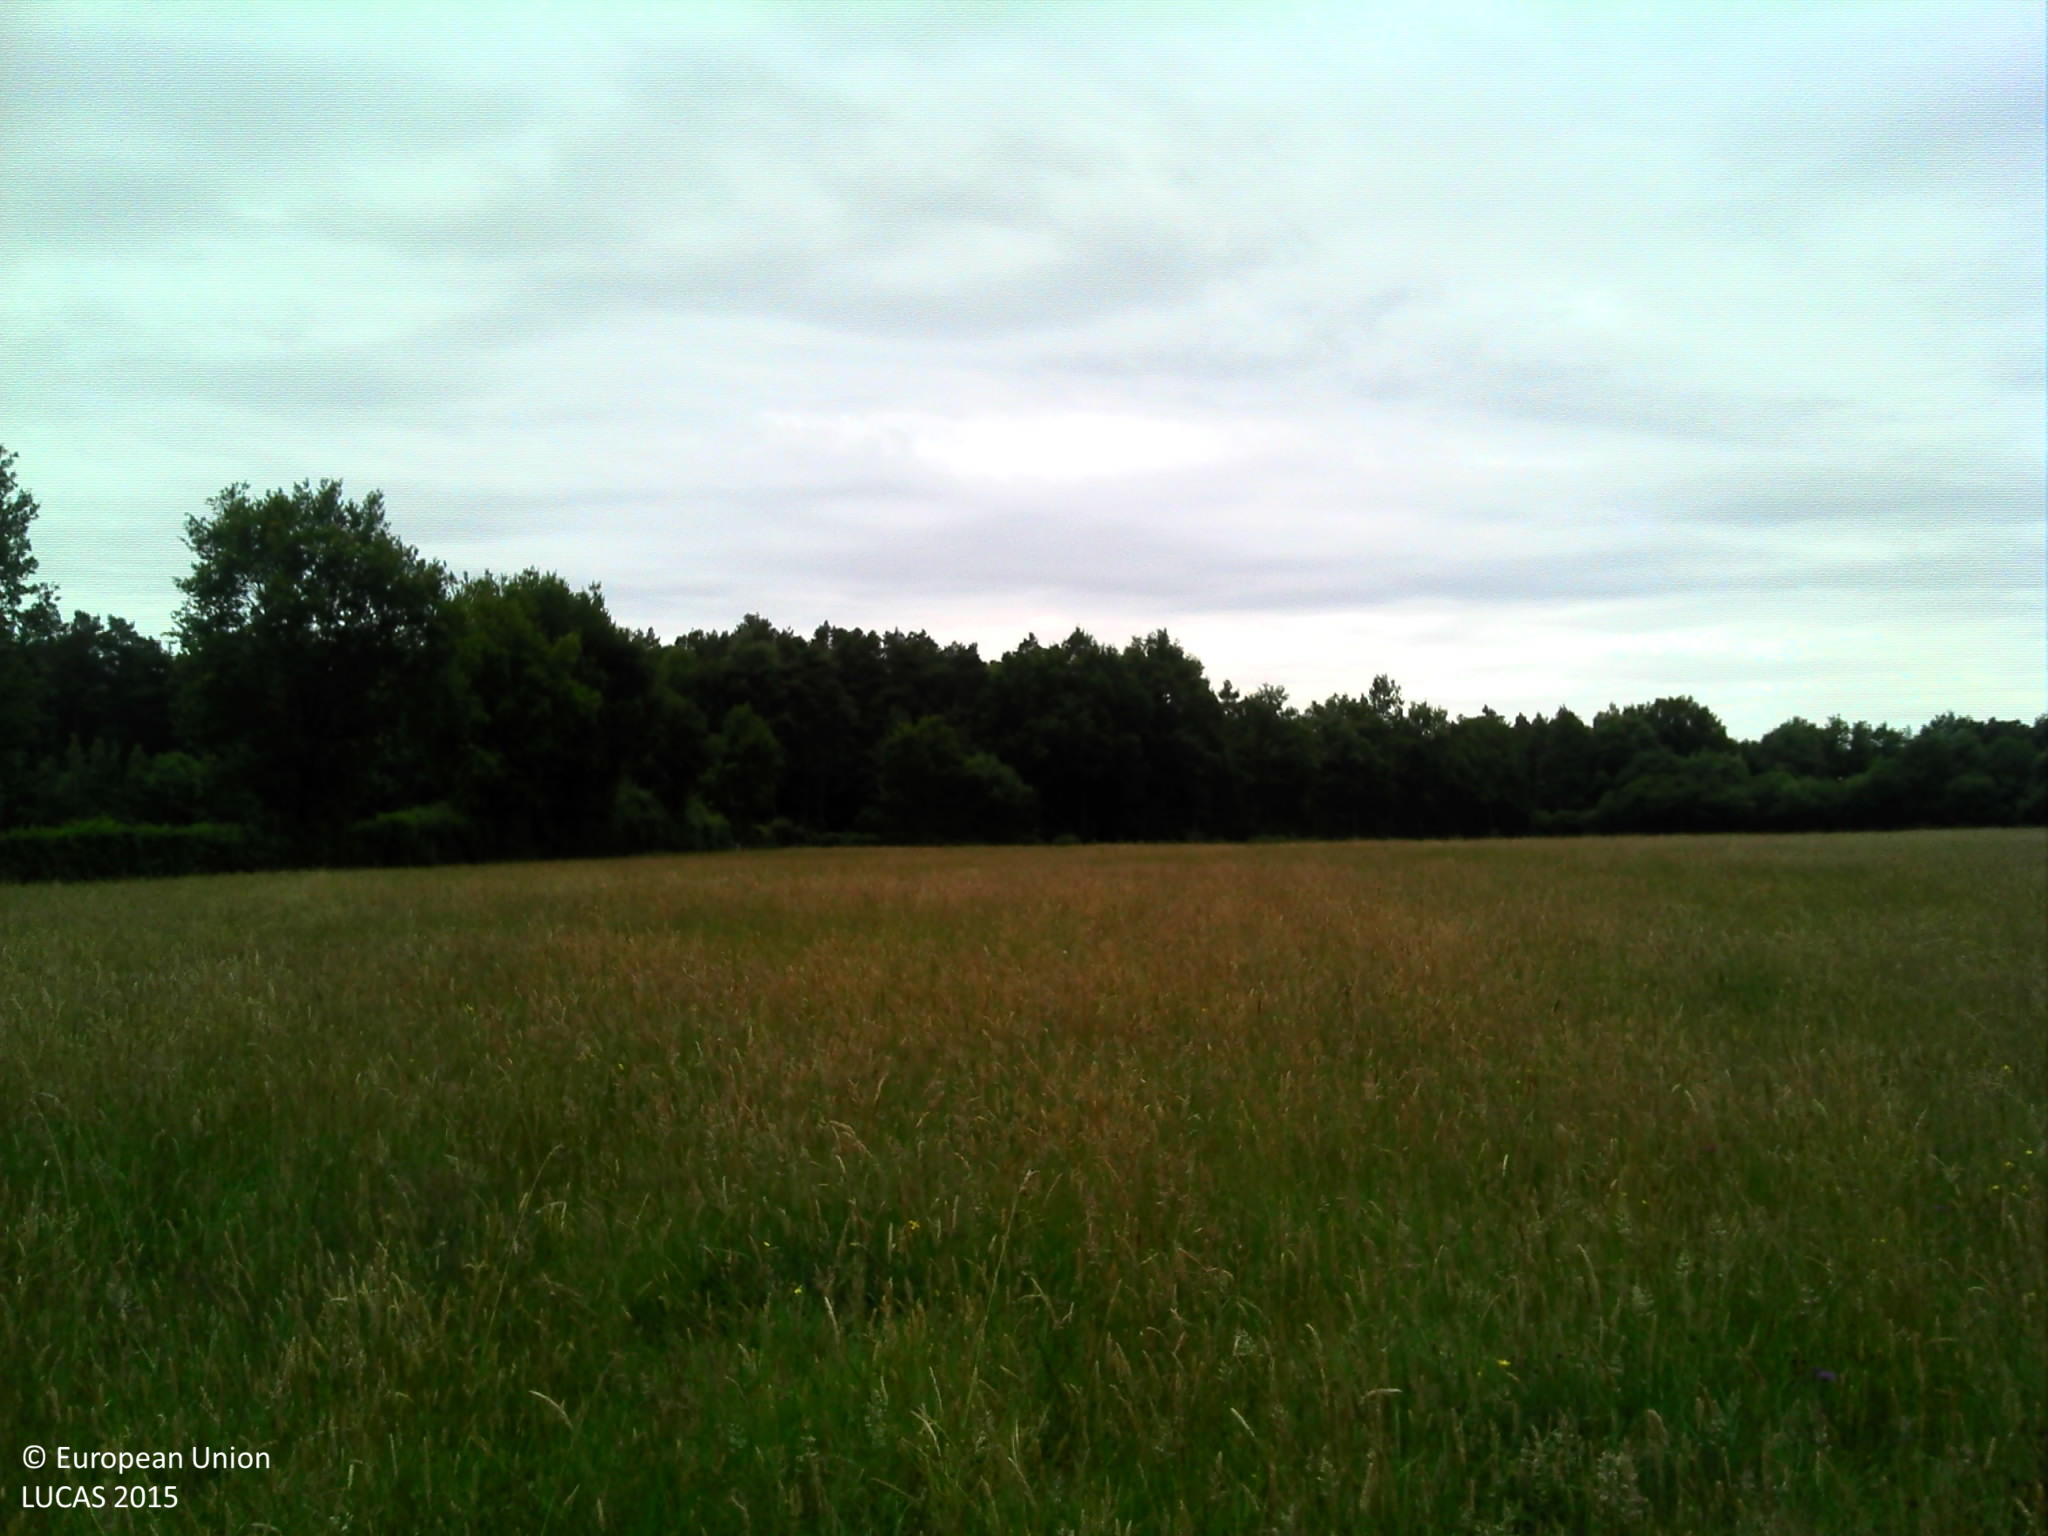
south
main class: Grassland
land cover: Grassland without tree/shrub cover
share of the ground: > 75 %
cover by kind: herbaceous plants 100 %
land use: Agriculture (excluding fallow land and kitchen gardens)
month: June
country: FR
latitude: 47.6460
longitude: 0.0565
